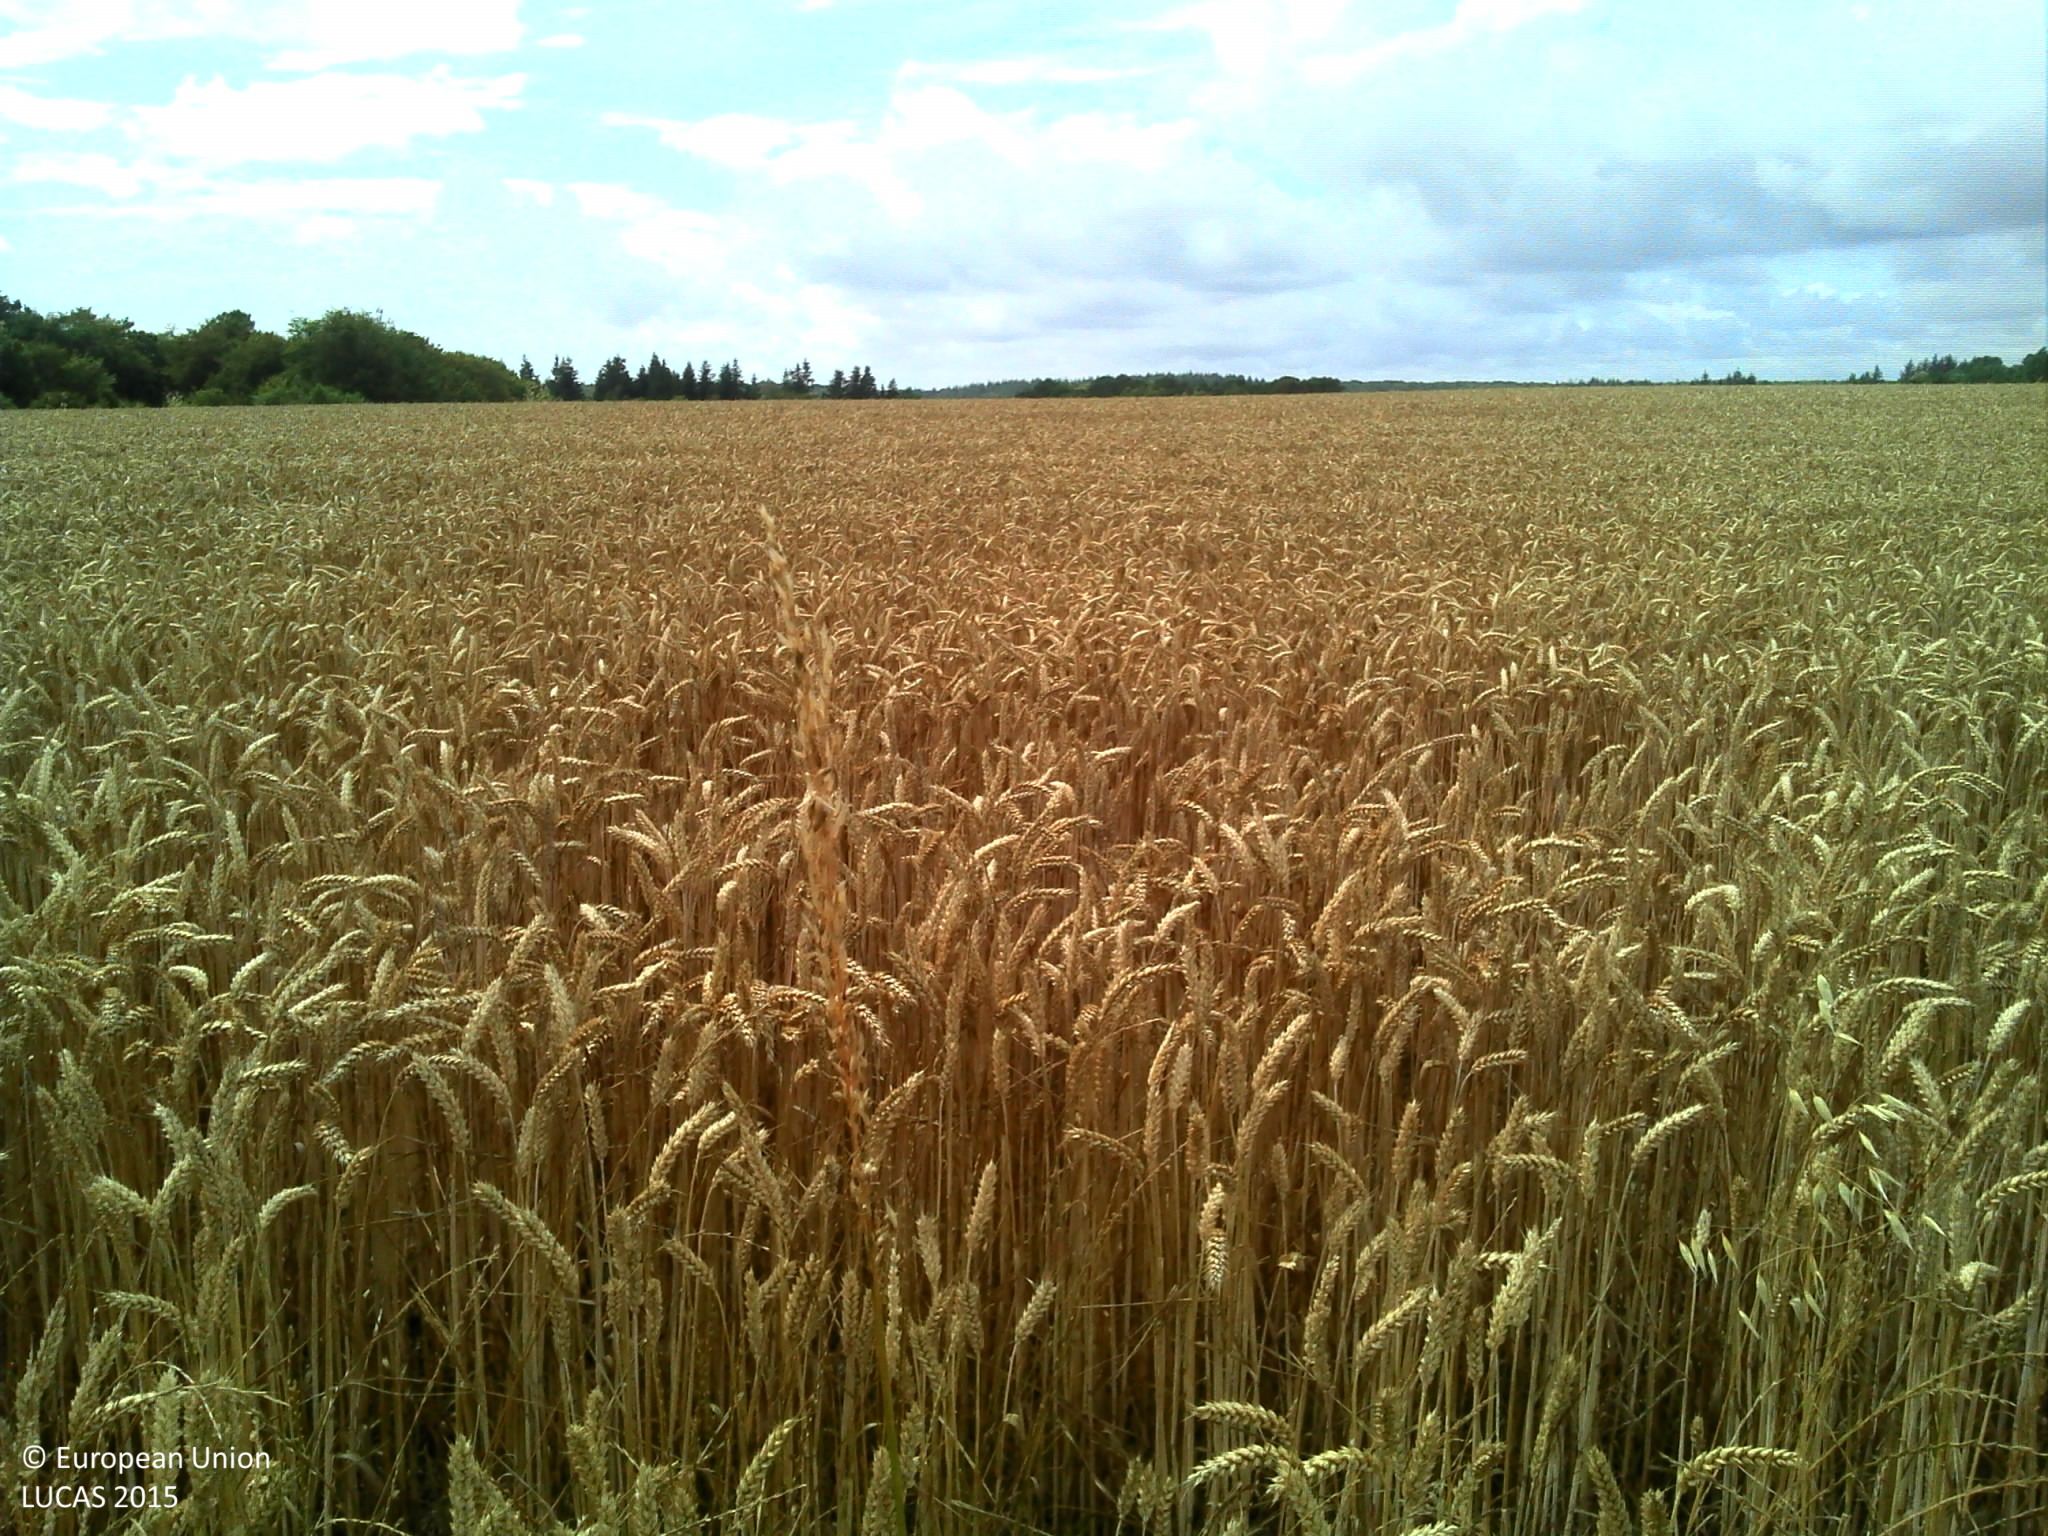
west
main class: Cropland
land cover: Common wheat
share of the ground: > 75 %
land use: Agriculture (excluding fallow land and kitchen gardens)
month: July
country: FR
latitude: 47.8229
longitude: -3.5267
